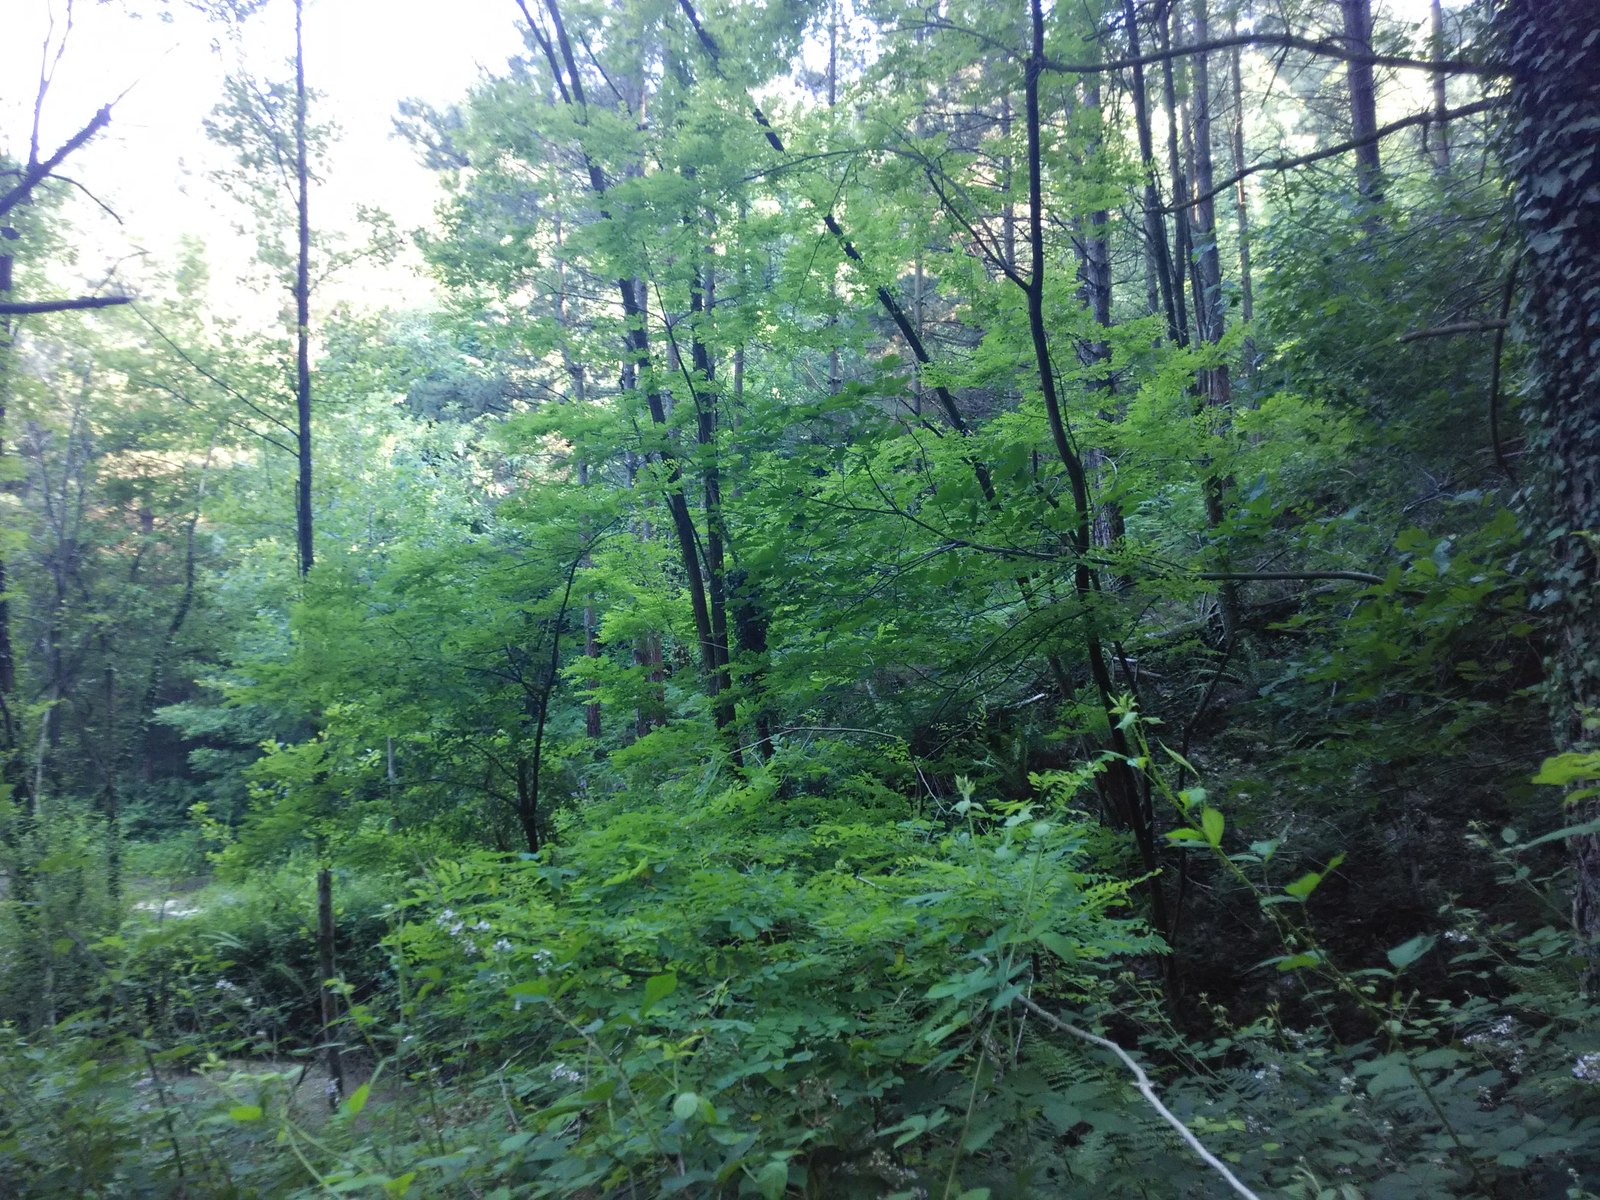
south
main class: Woodland
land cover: Pine dominated coniferous woodland
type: exotic forest
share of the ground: > 75 %
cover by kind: coniferous forest trees 90 %, broadleaved forest trees 10 %
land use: Forestry
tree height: > 5 m
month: June
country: ES
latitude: 43.0755
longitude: -2.5424
